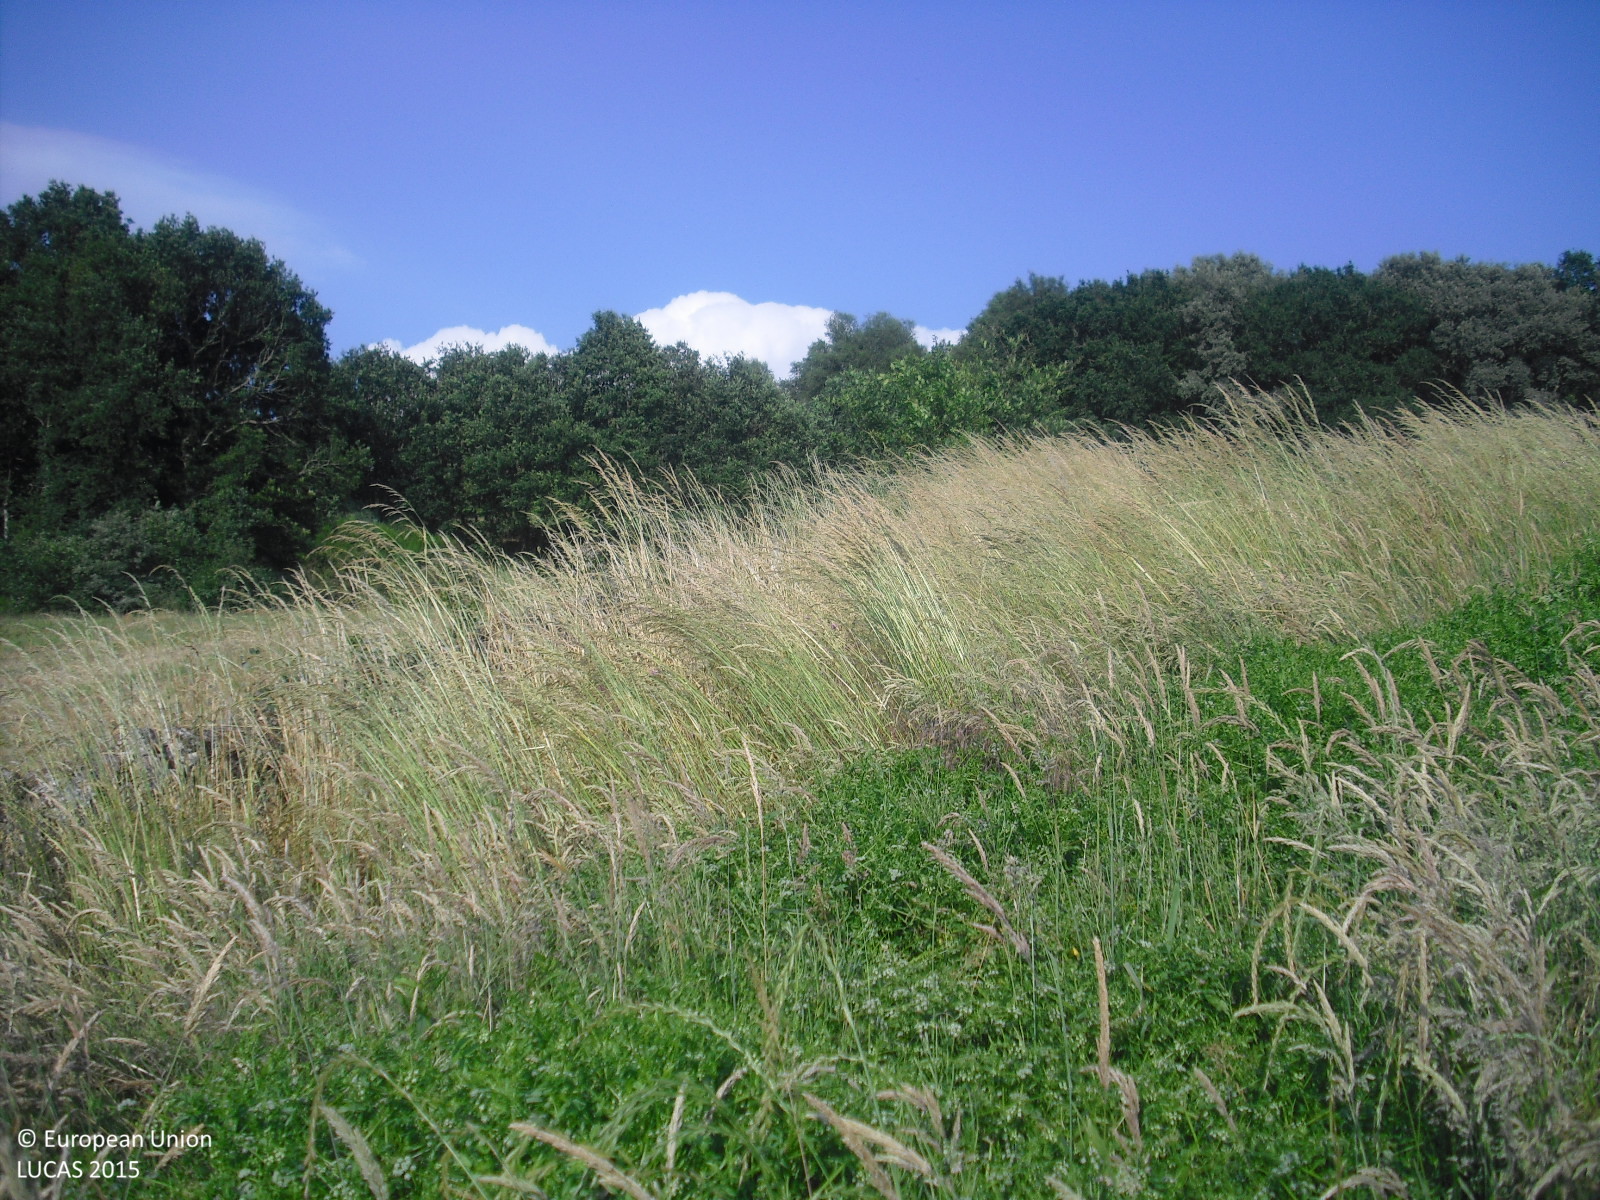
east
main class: Cropland
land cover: Temporary grasslands
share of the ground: > 75 %
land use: Agriculture (excluding fallow land and kitchen gardens)
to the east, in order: Temporary grasslands; Grass margins; Dry stone walls; Grassland without tree/shrub cover; Dry stone walls; Temporary grasslands; Dry stone walls; Groves; Shruby margins; Grassland without tree/shrub cover; Ditches and canals; Broadleaved woodland; Ditches and canals; Broadleaved woodland; Pine dominated mixed woodland; Dry stone walls; Tracks; Dry stone walls; Pine dominated coniferous woodland
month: June
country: ES
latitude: 42.5874
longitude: -7.8339
